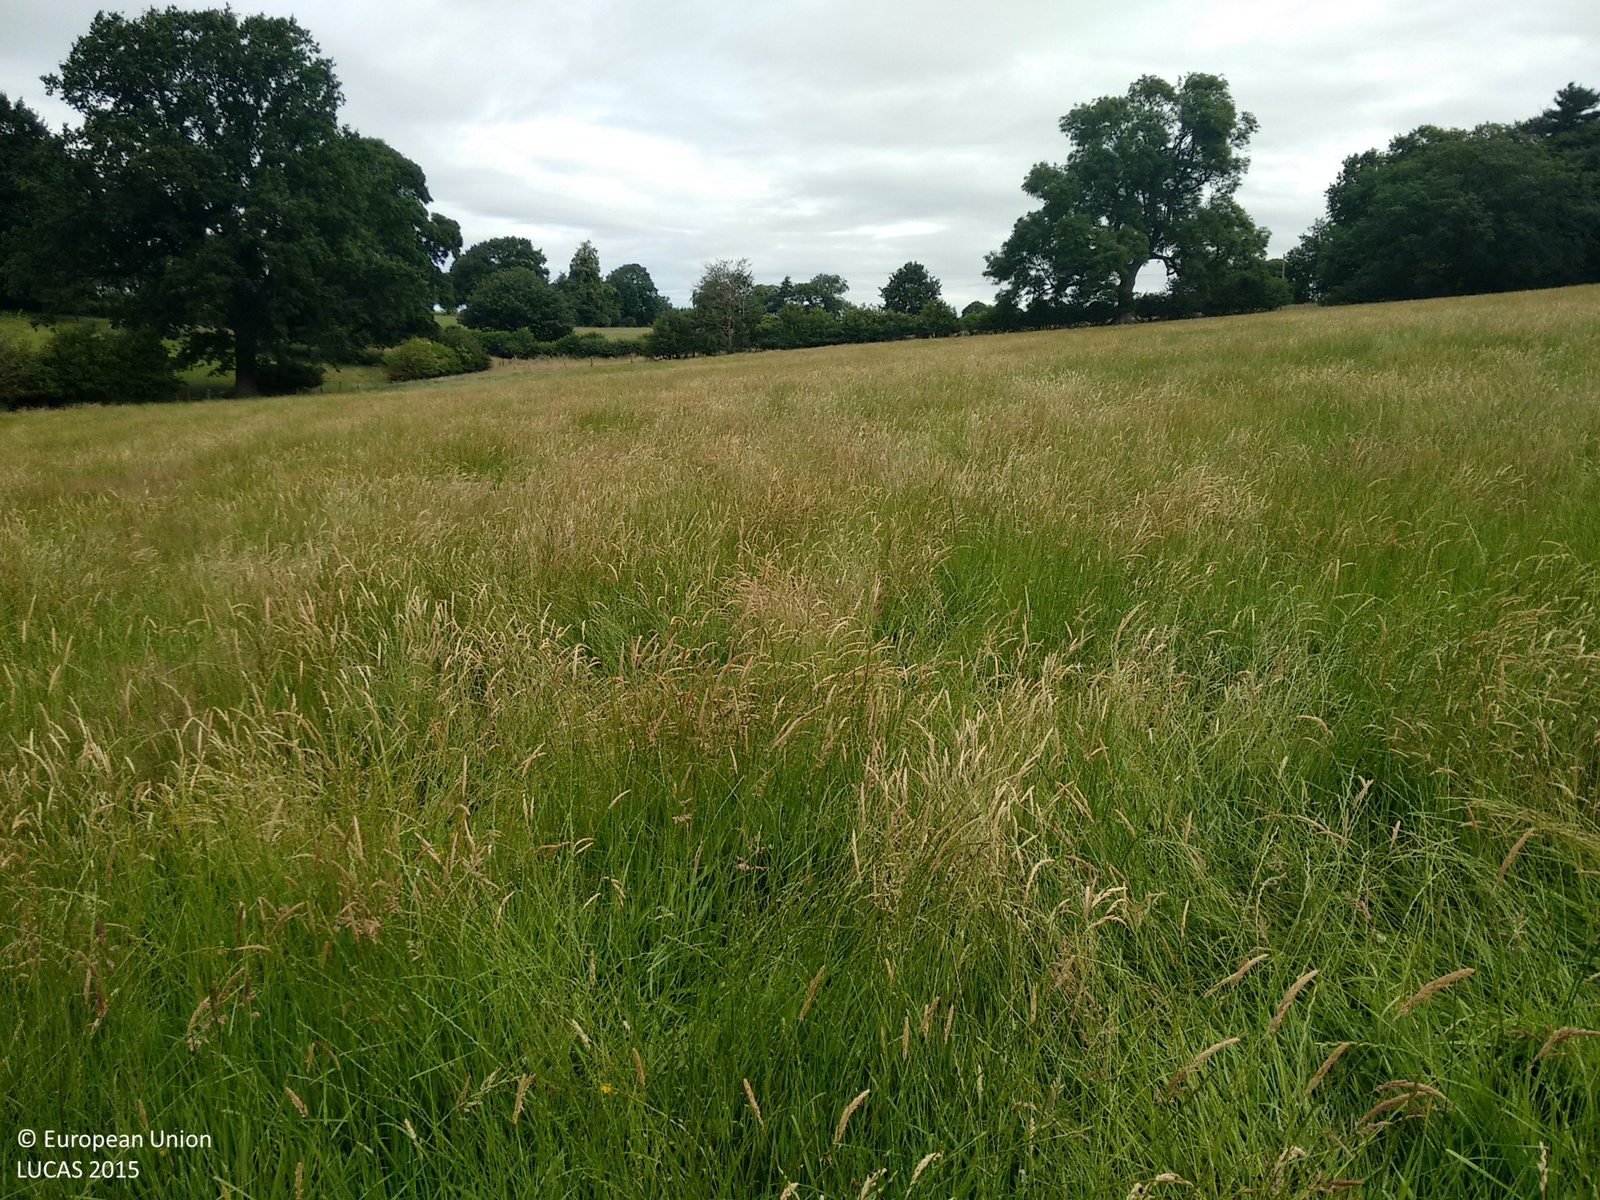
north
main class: Grassland
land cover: Grassland without tree/shrub cover
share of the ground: > 75 %
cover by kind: herbaceous plants 100 %
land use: Agriculture (excluding fallow land and kitchen gardens)
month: July
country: GB
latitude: 52.9554
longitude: -1.5577
